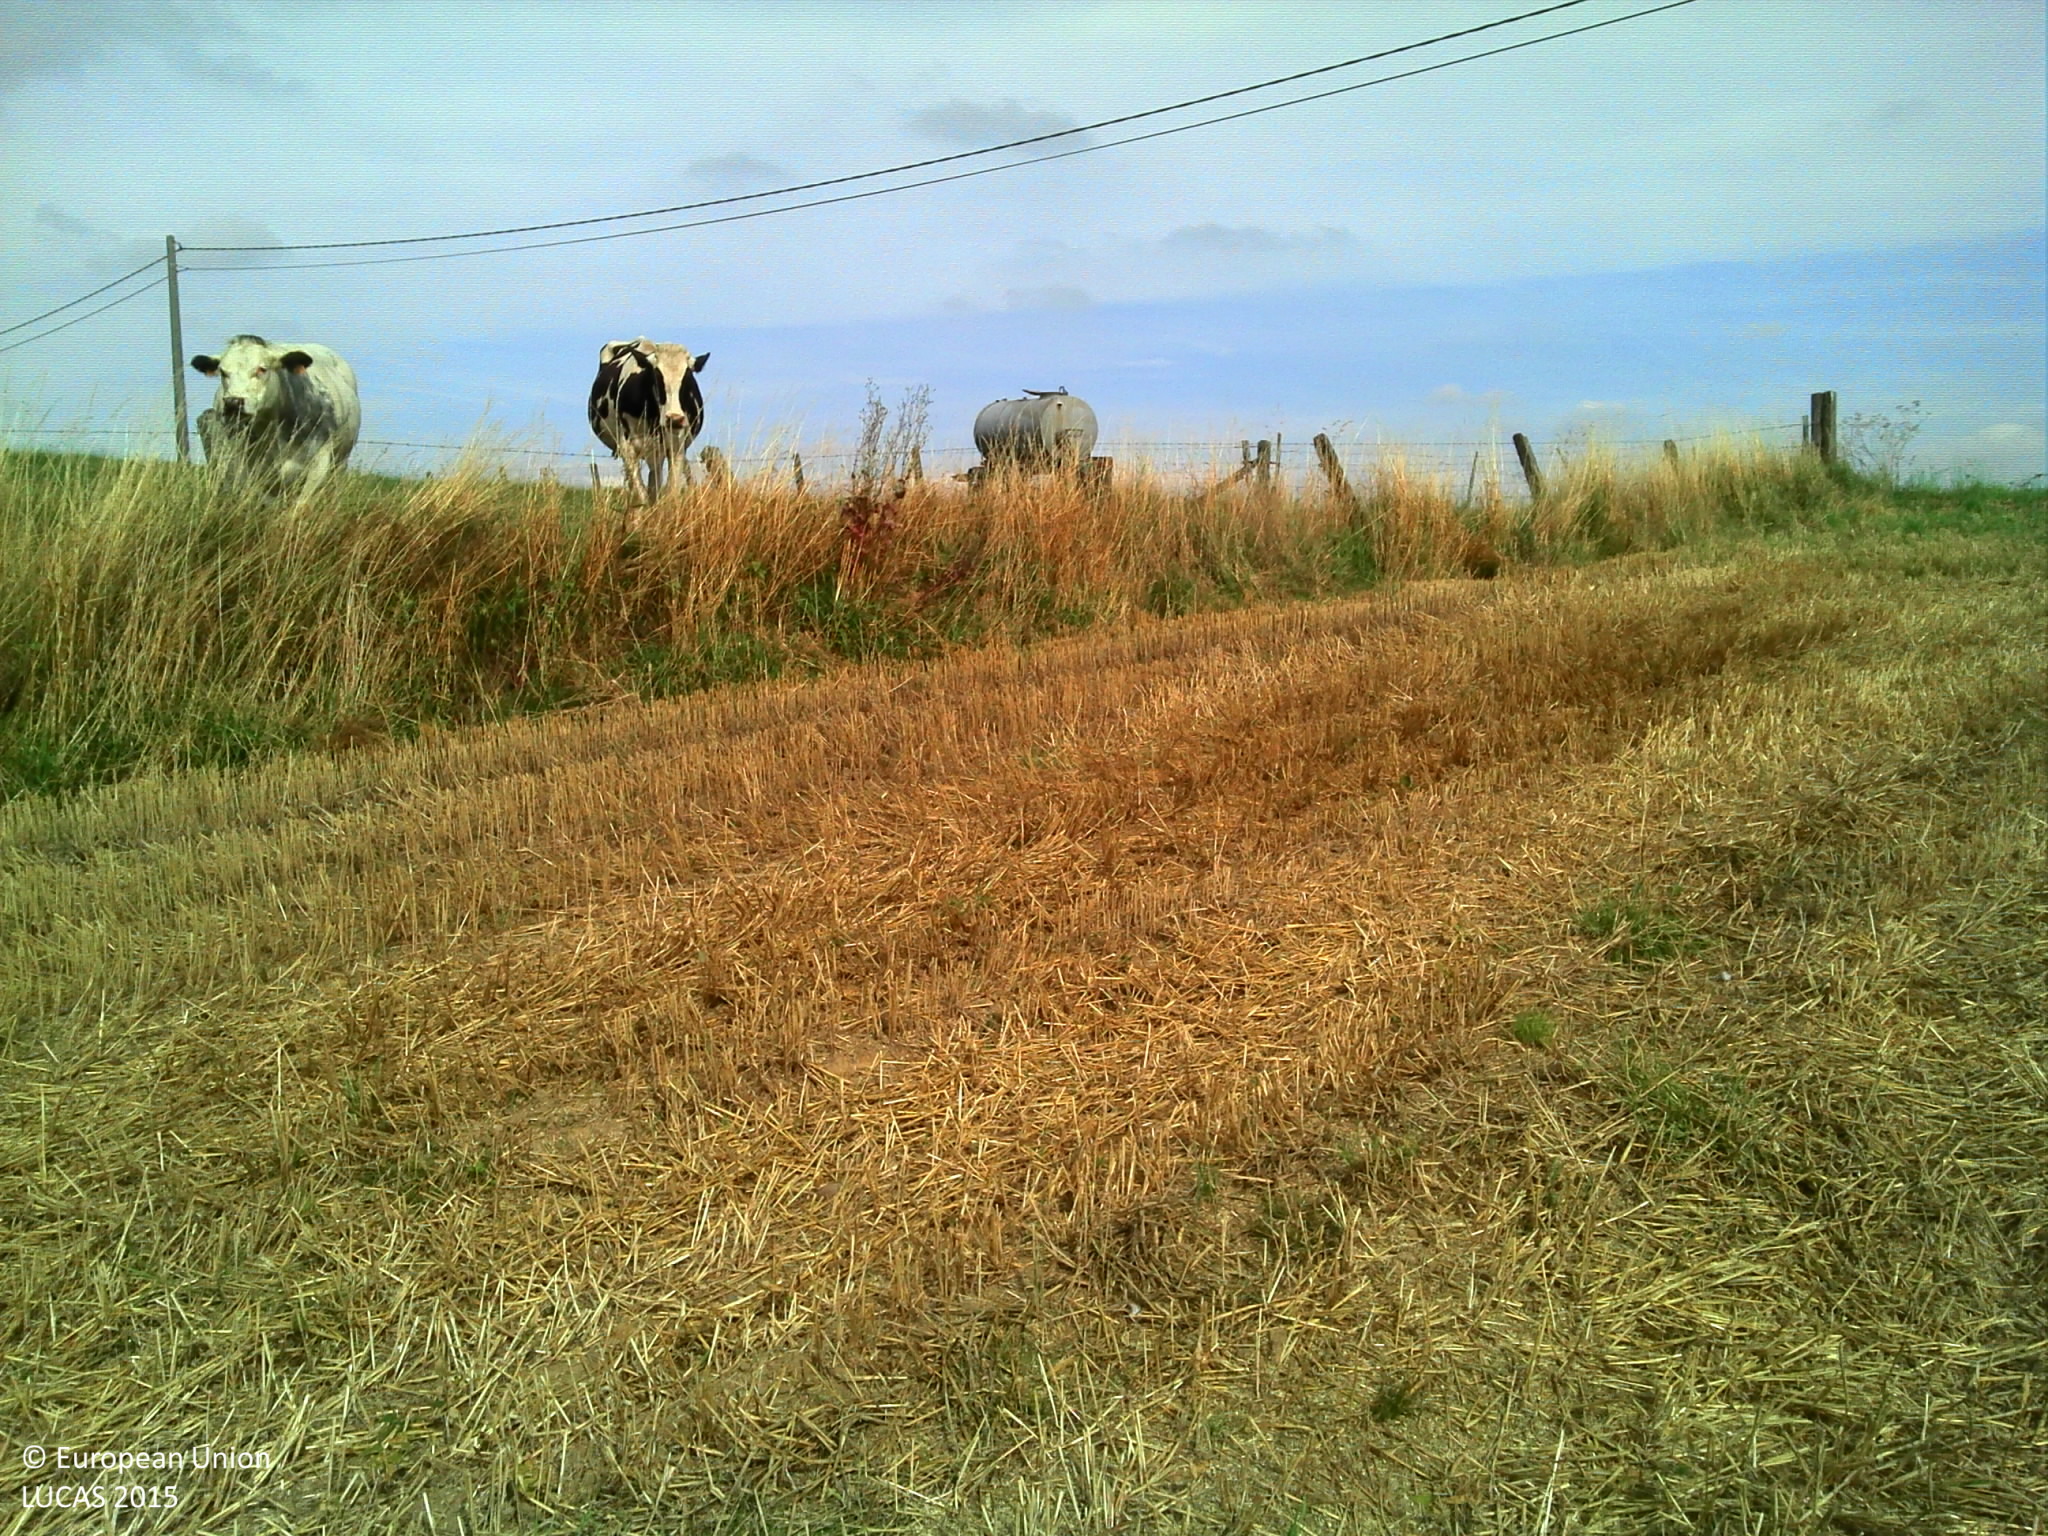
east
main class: Cropland
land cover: Common wheat
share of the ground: > 75 %
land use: Agriculture (excluding fallow land and kitchen gardens)
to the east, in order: Common wheat; Grass margins; Fences; Grassland without tree/shrub cover; Fences; Electric lines; Grass margins; Paved roads, cycling and walking lanes; Grass margins; Ditches and canals; Grass margins; Other bare soil; Potatoes; Temporary grasslands
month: August
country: BE
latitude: 50.7129
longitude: 3.6908
